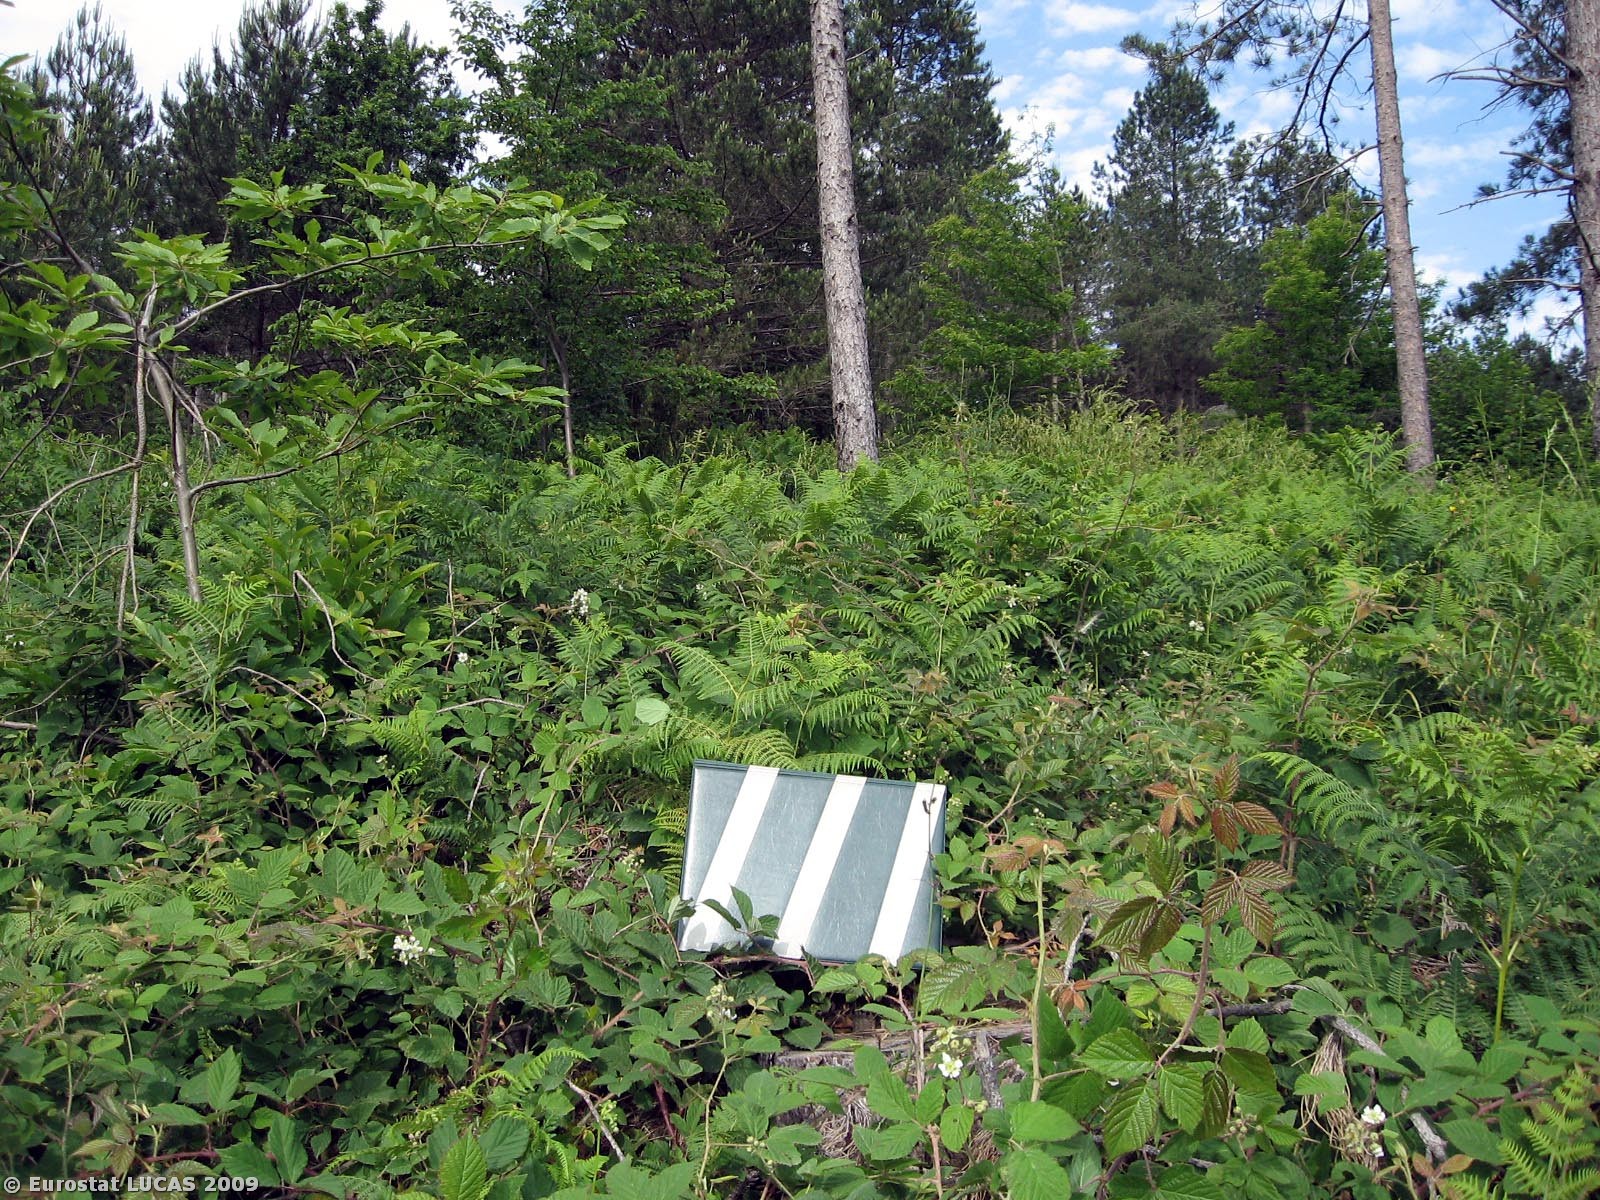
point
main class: Woodland
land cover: Coniferous woodland
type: coniferous forest of the mediterranean region
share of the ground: 25 - 50 %
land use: Forestry
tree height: > 5 m
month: June
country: IT
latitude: 38.7506
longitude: 16.3976
